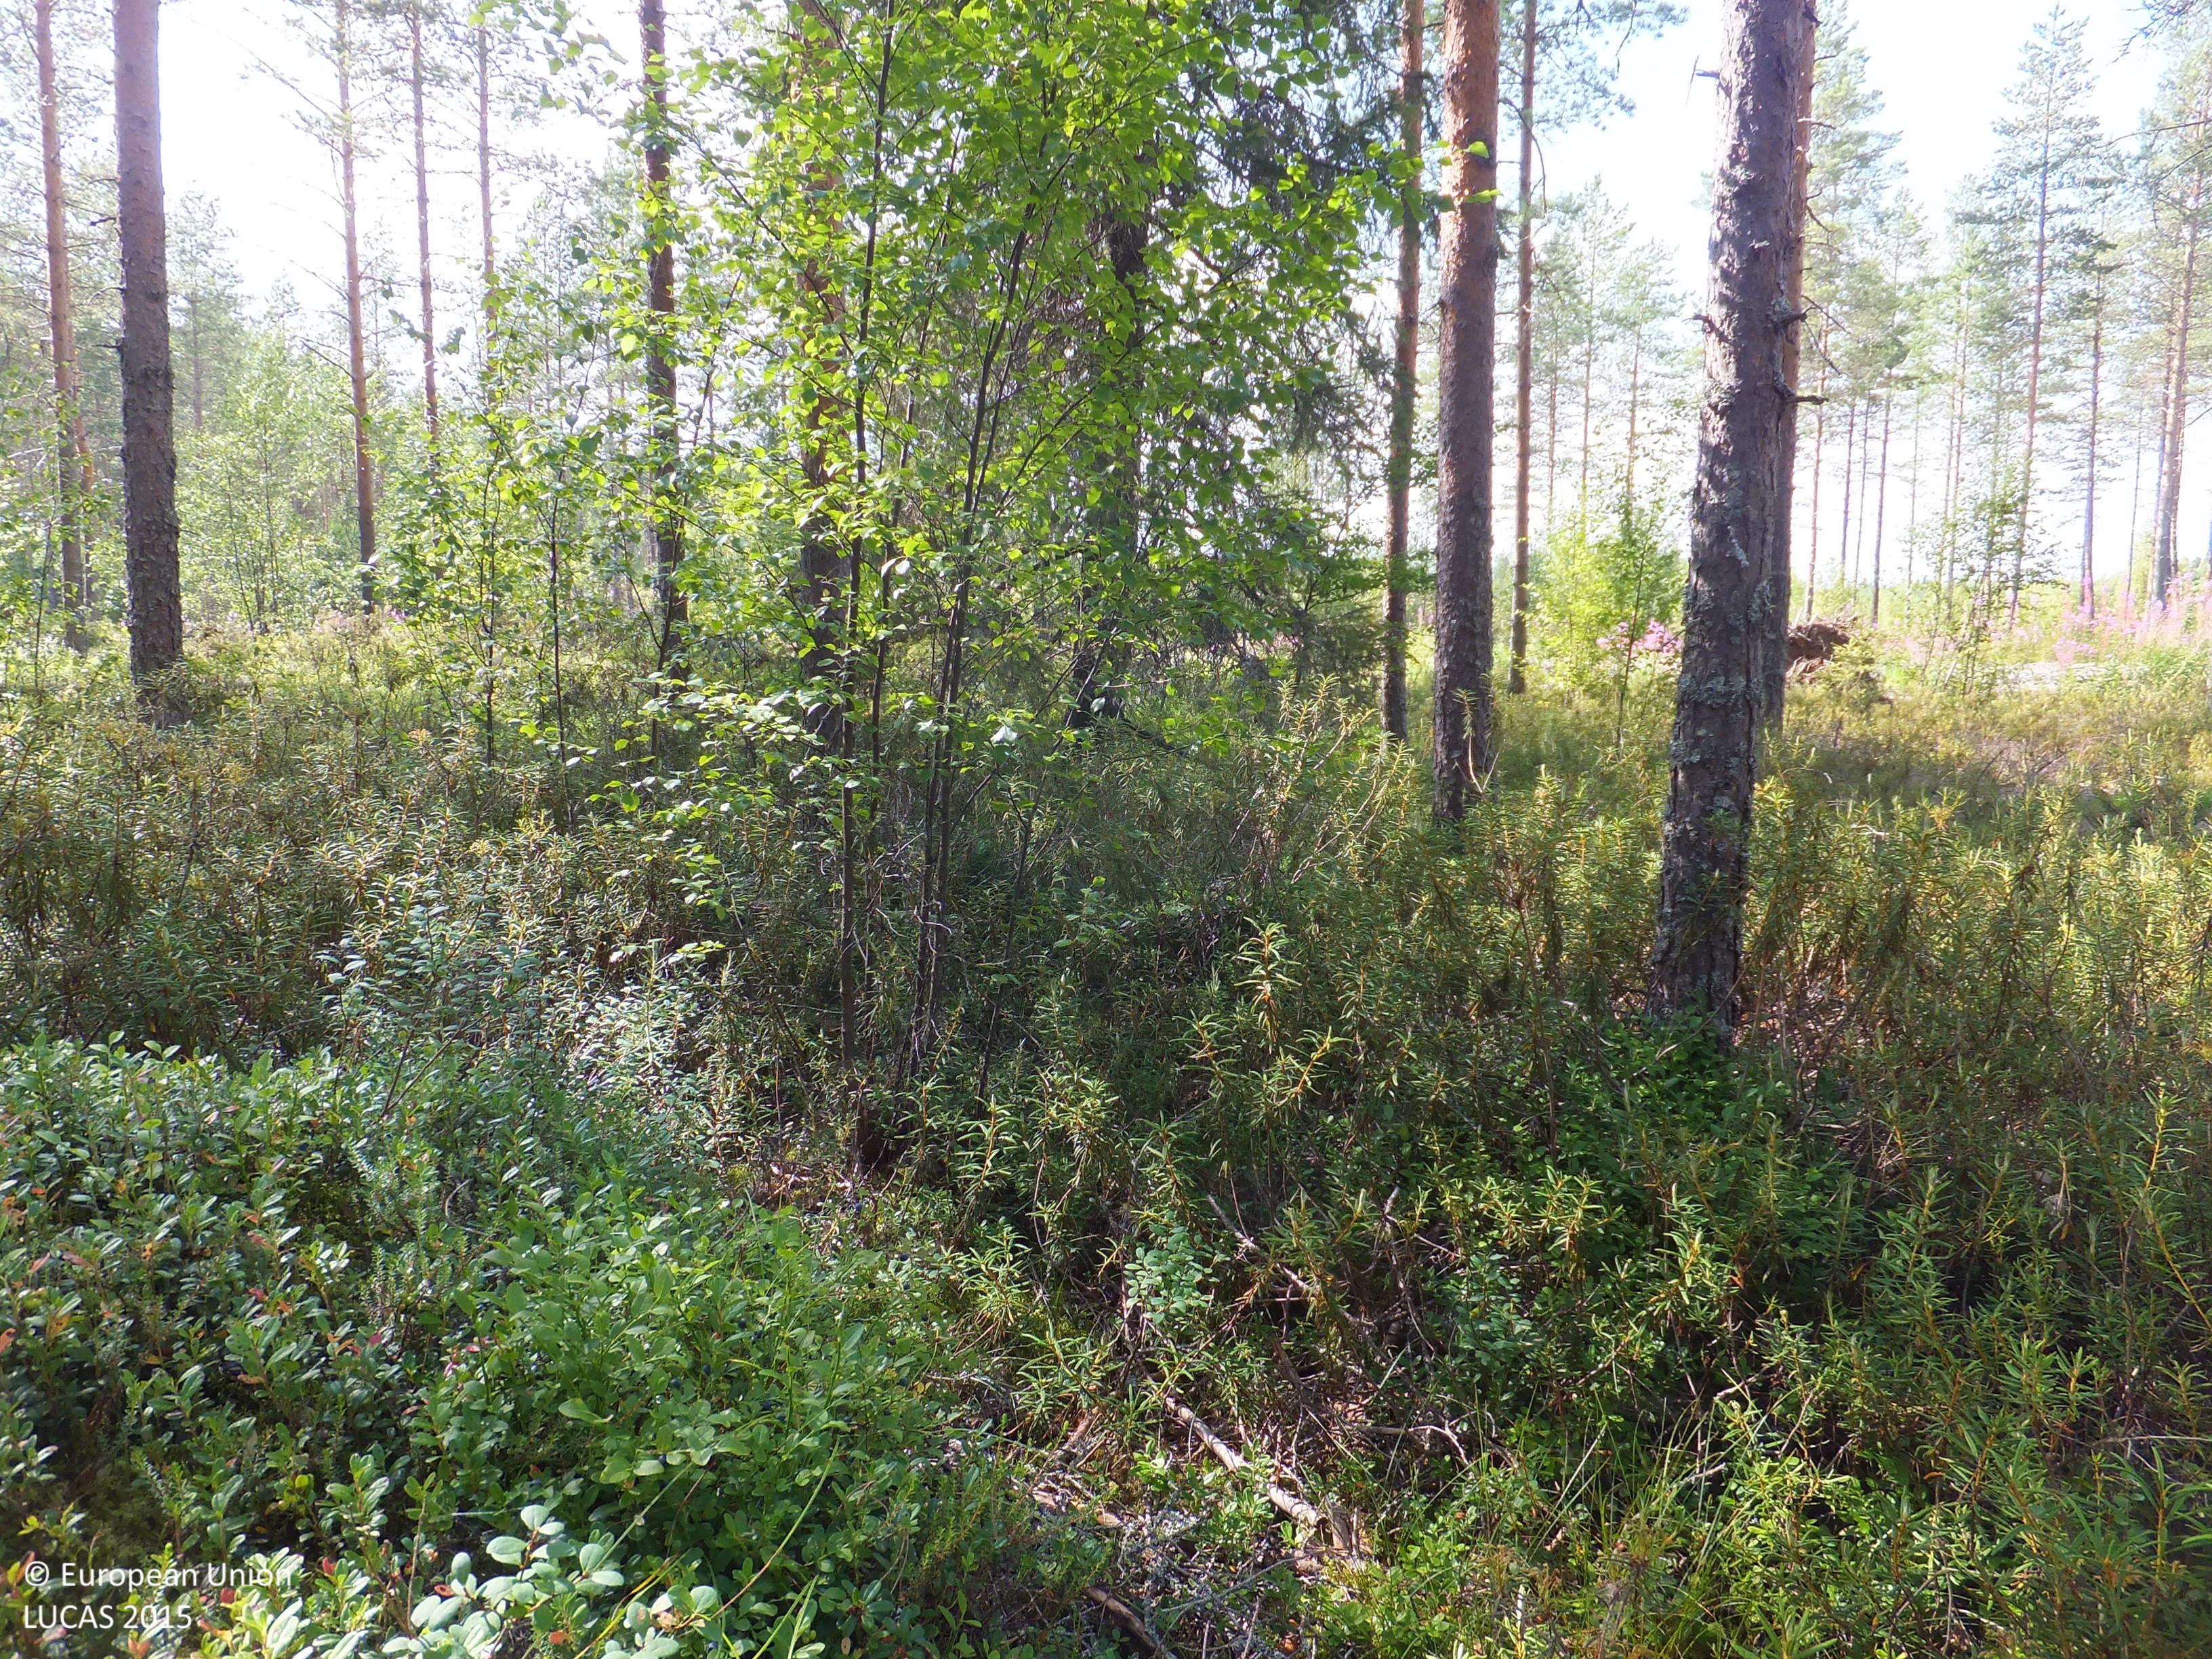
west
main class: Woodland
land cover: Pine dominated coniferous woodland
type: boreal forest
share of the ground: > 75 %
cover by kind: coniferous forest trees 70 %, broadleaved forest trees 10 %, shrubs 10 %, herbaceous plants 5 %, lichens and mosses 5 %
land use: Forestry
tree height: > 5 m
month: August
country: FI
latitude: 63.2058
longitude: 22.7187
